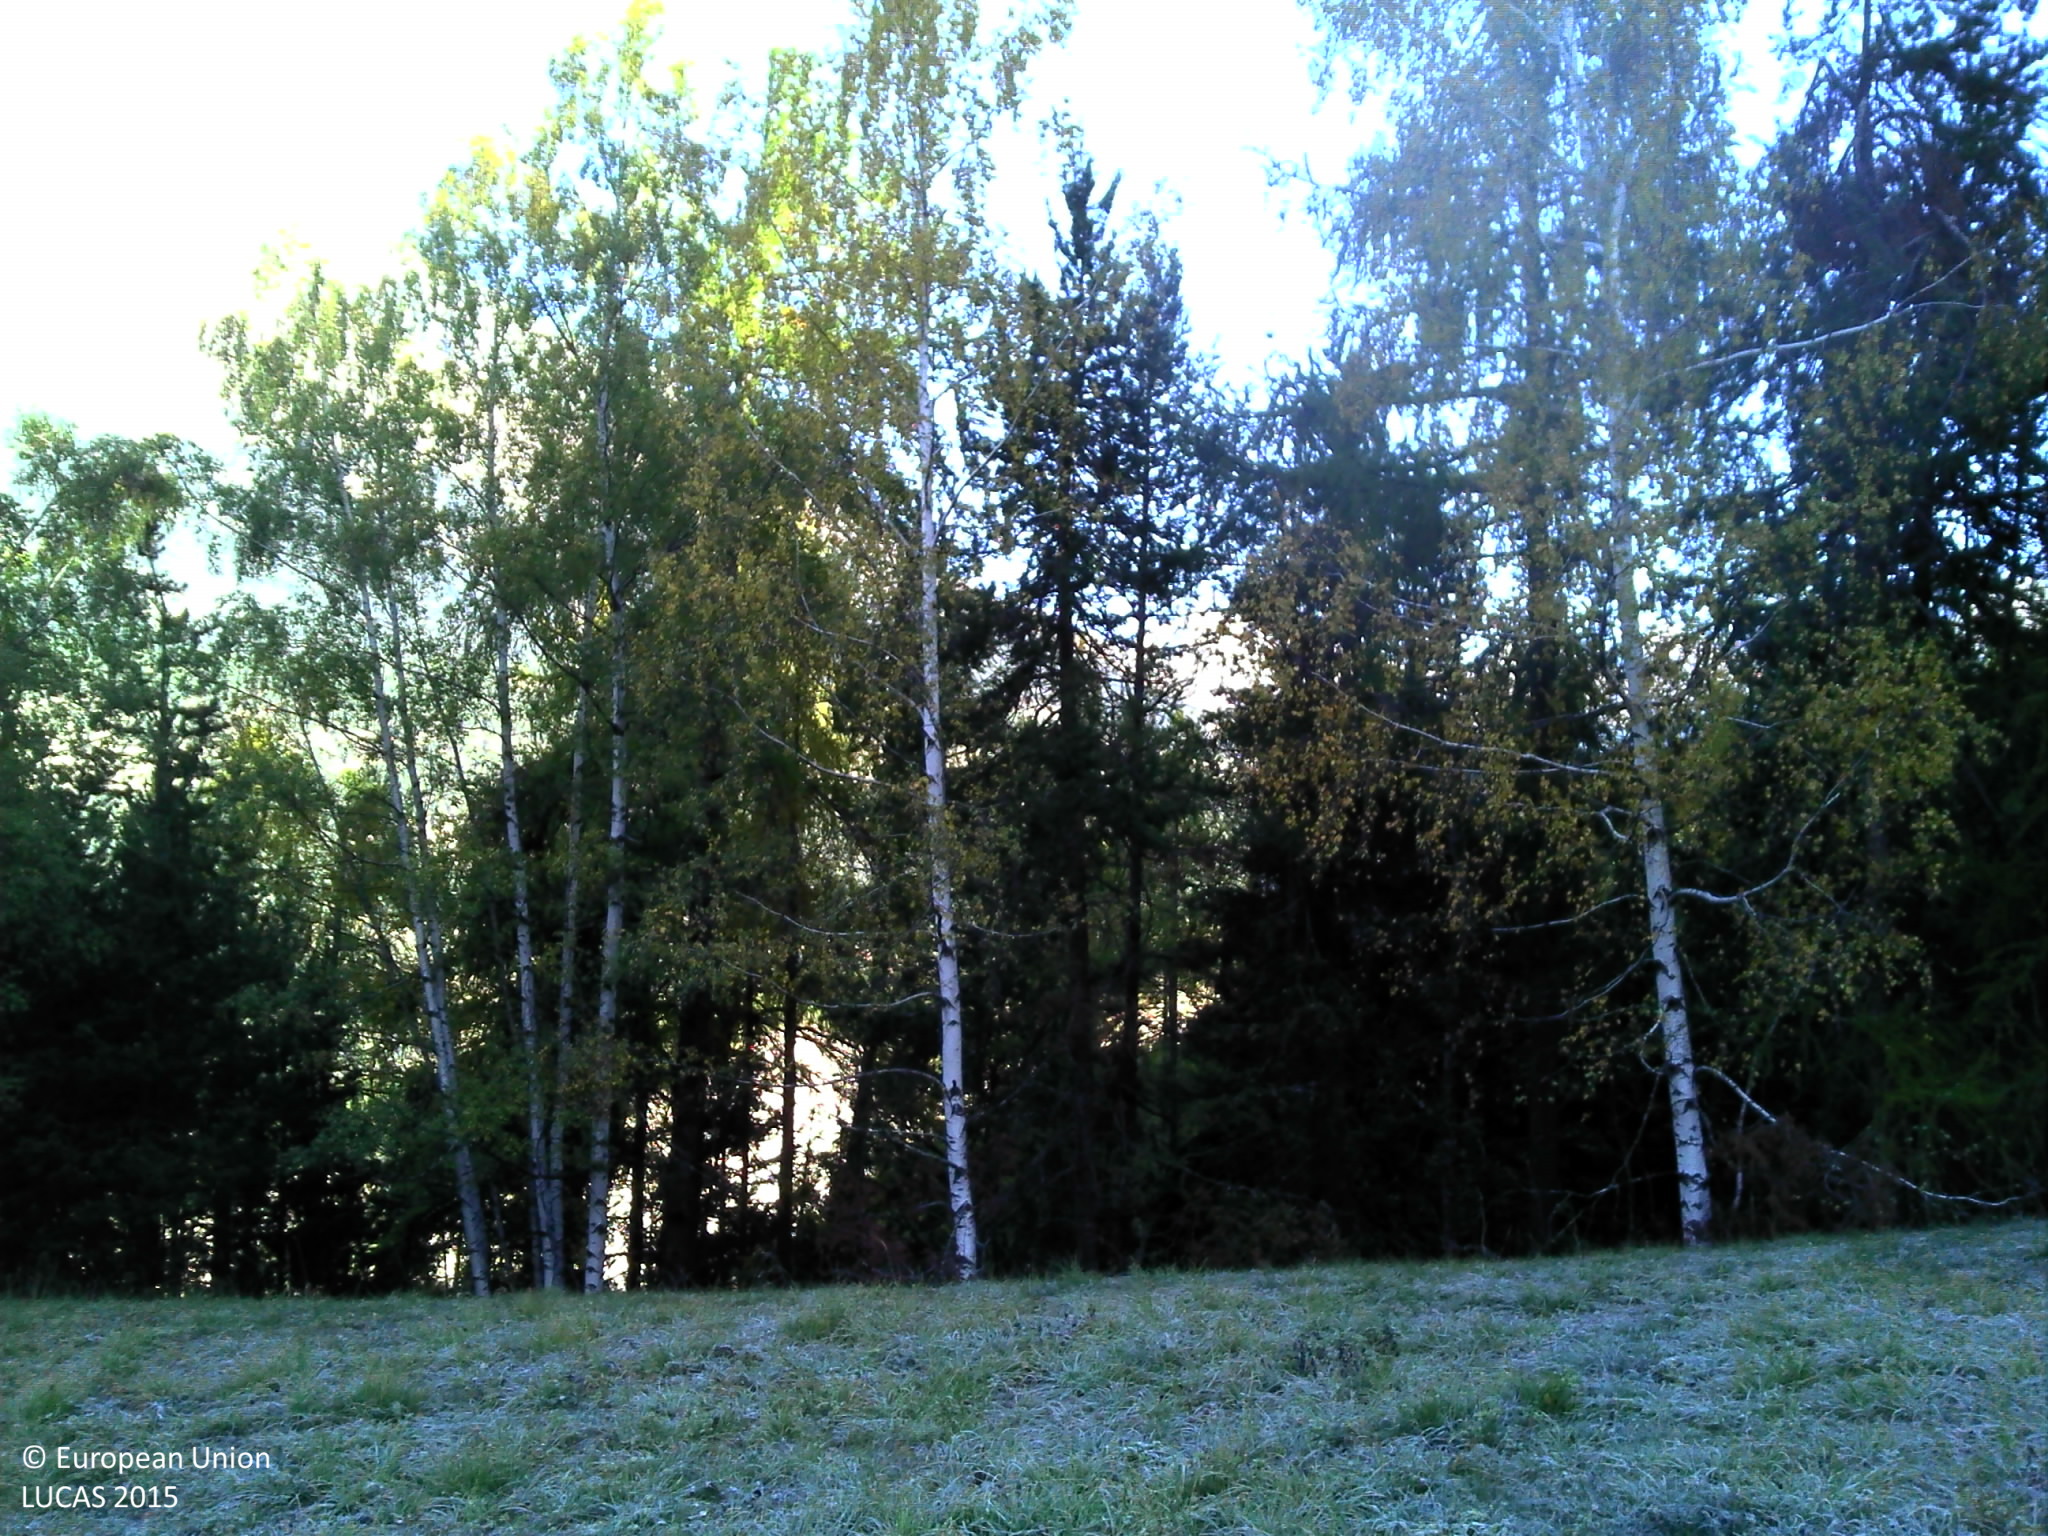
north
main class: Grassland
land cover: Grassland without tree/shrub cover
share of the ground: > 75 %
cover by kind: herbaceous plants 95 %, consolidated bare surface 5 %
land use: Agriculture (excluding fallow land and kitchen gardens)
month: October
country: FR
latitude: 45.2209
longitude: 6.7829
